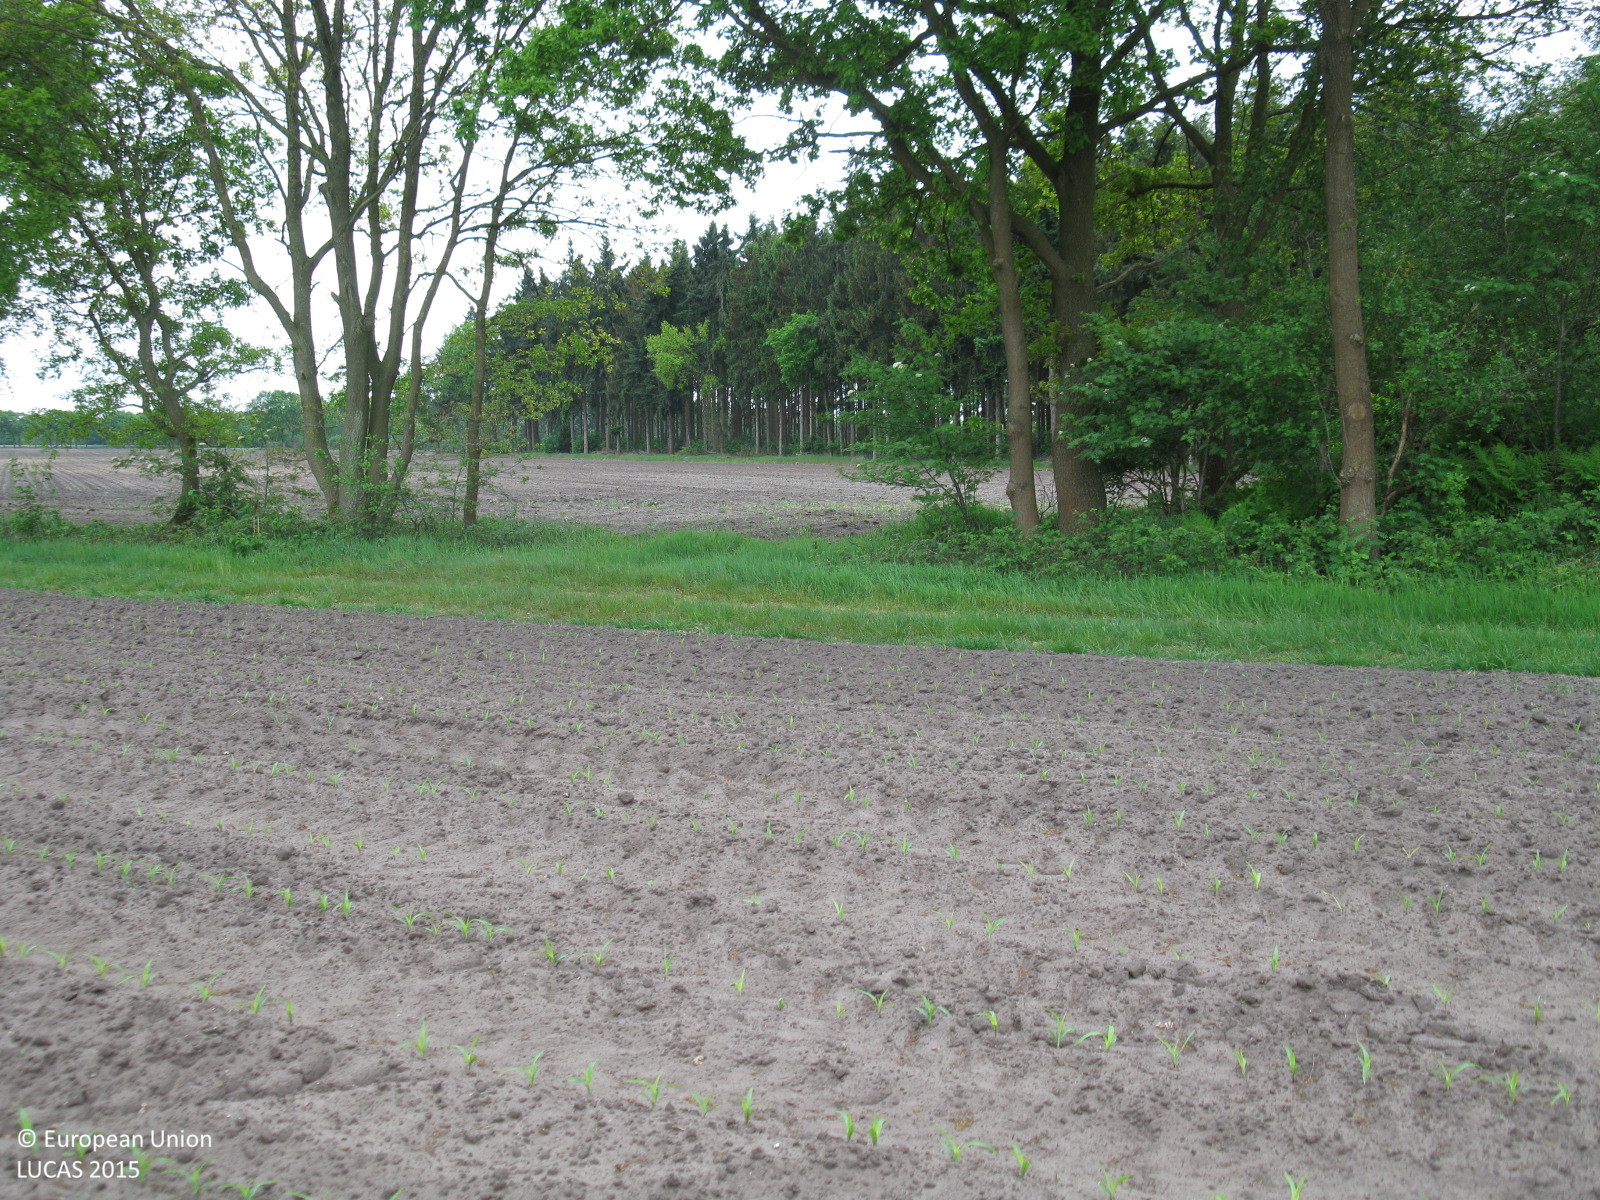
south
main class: Cropland
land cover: Maize
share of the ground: < 10 %
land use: Agriculture (excluding fallow land and kitchen gardens)
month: May
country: DE
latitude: 52.9708
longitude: 7.9308
